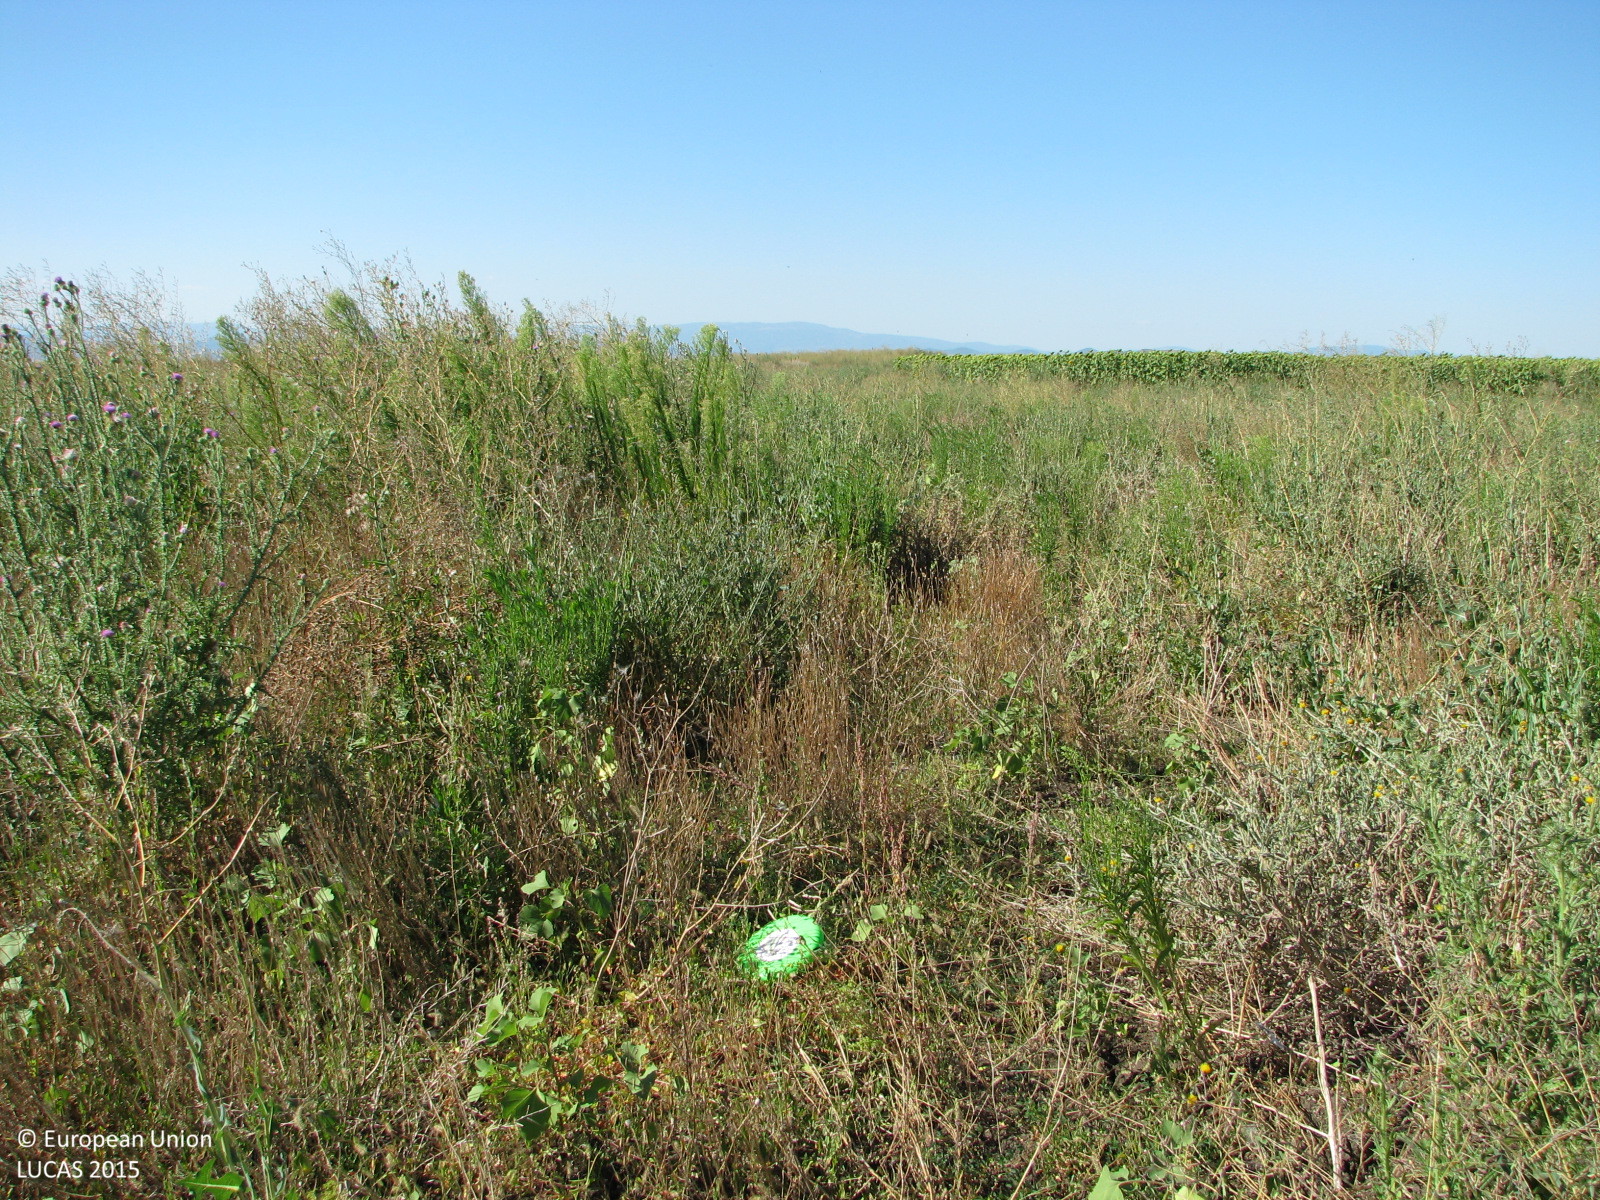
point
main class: Grassland
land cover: Spontaneously vegetated surfaces
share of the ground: > 75 %
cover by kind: herbaceous plants 100 %
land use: Fallow land
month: July
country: BG
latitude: 42.3788
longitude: 26.0264
